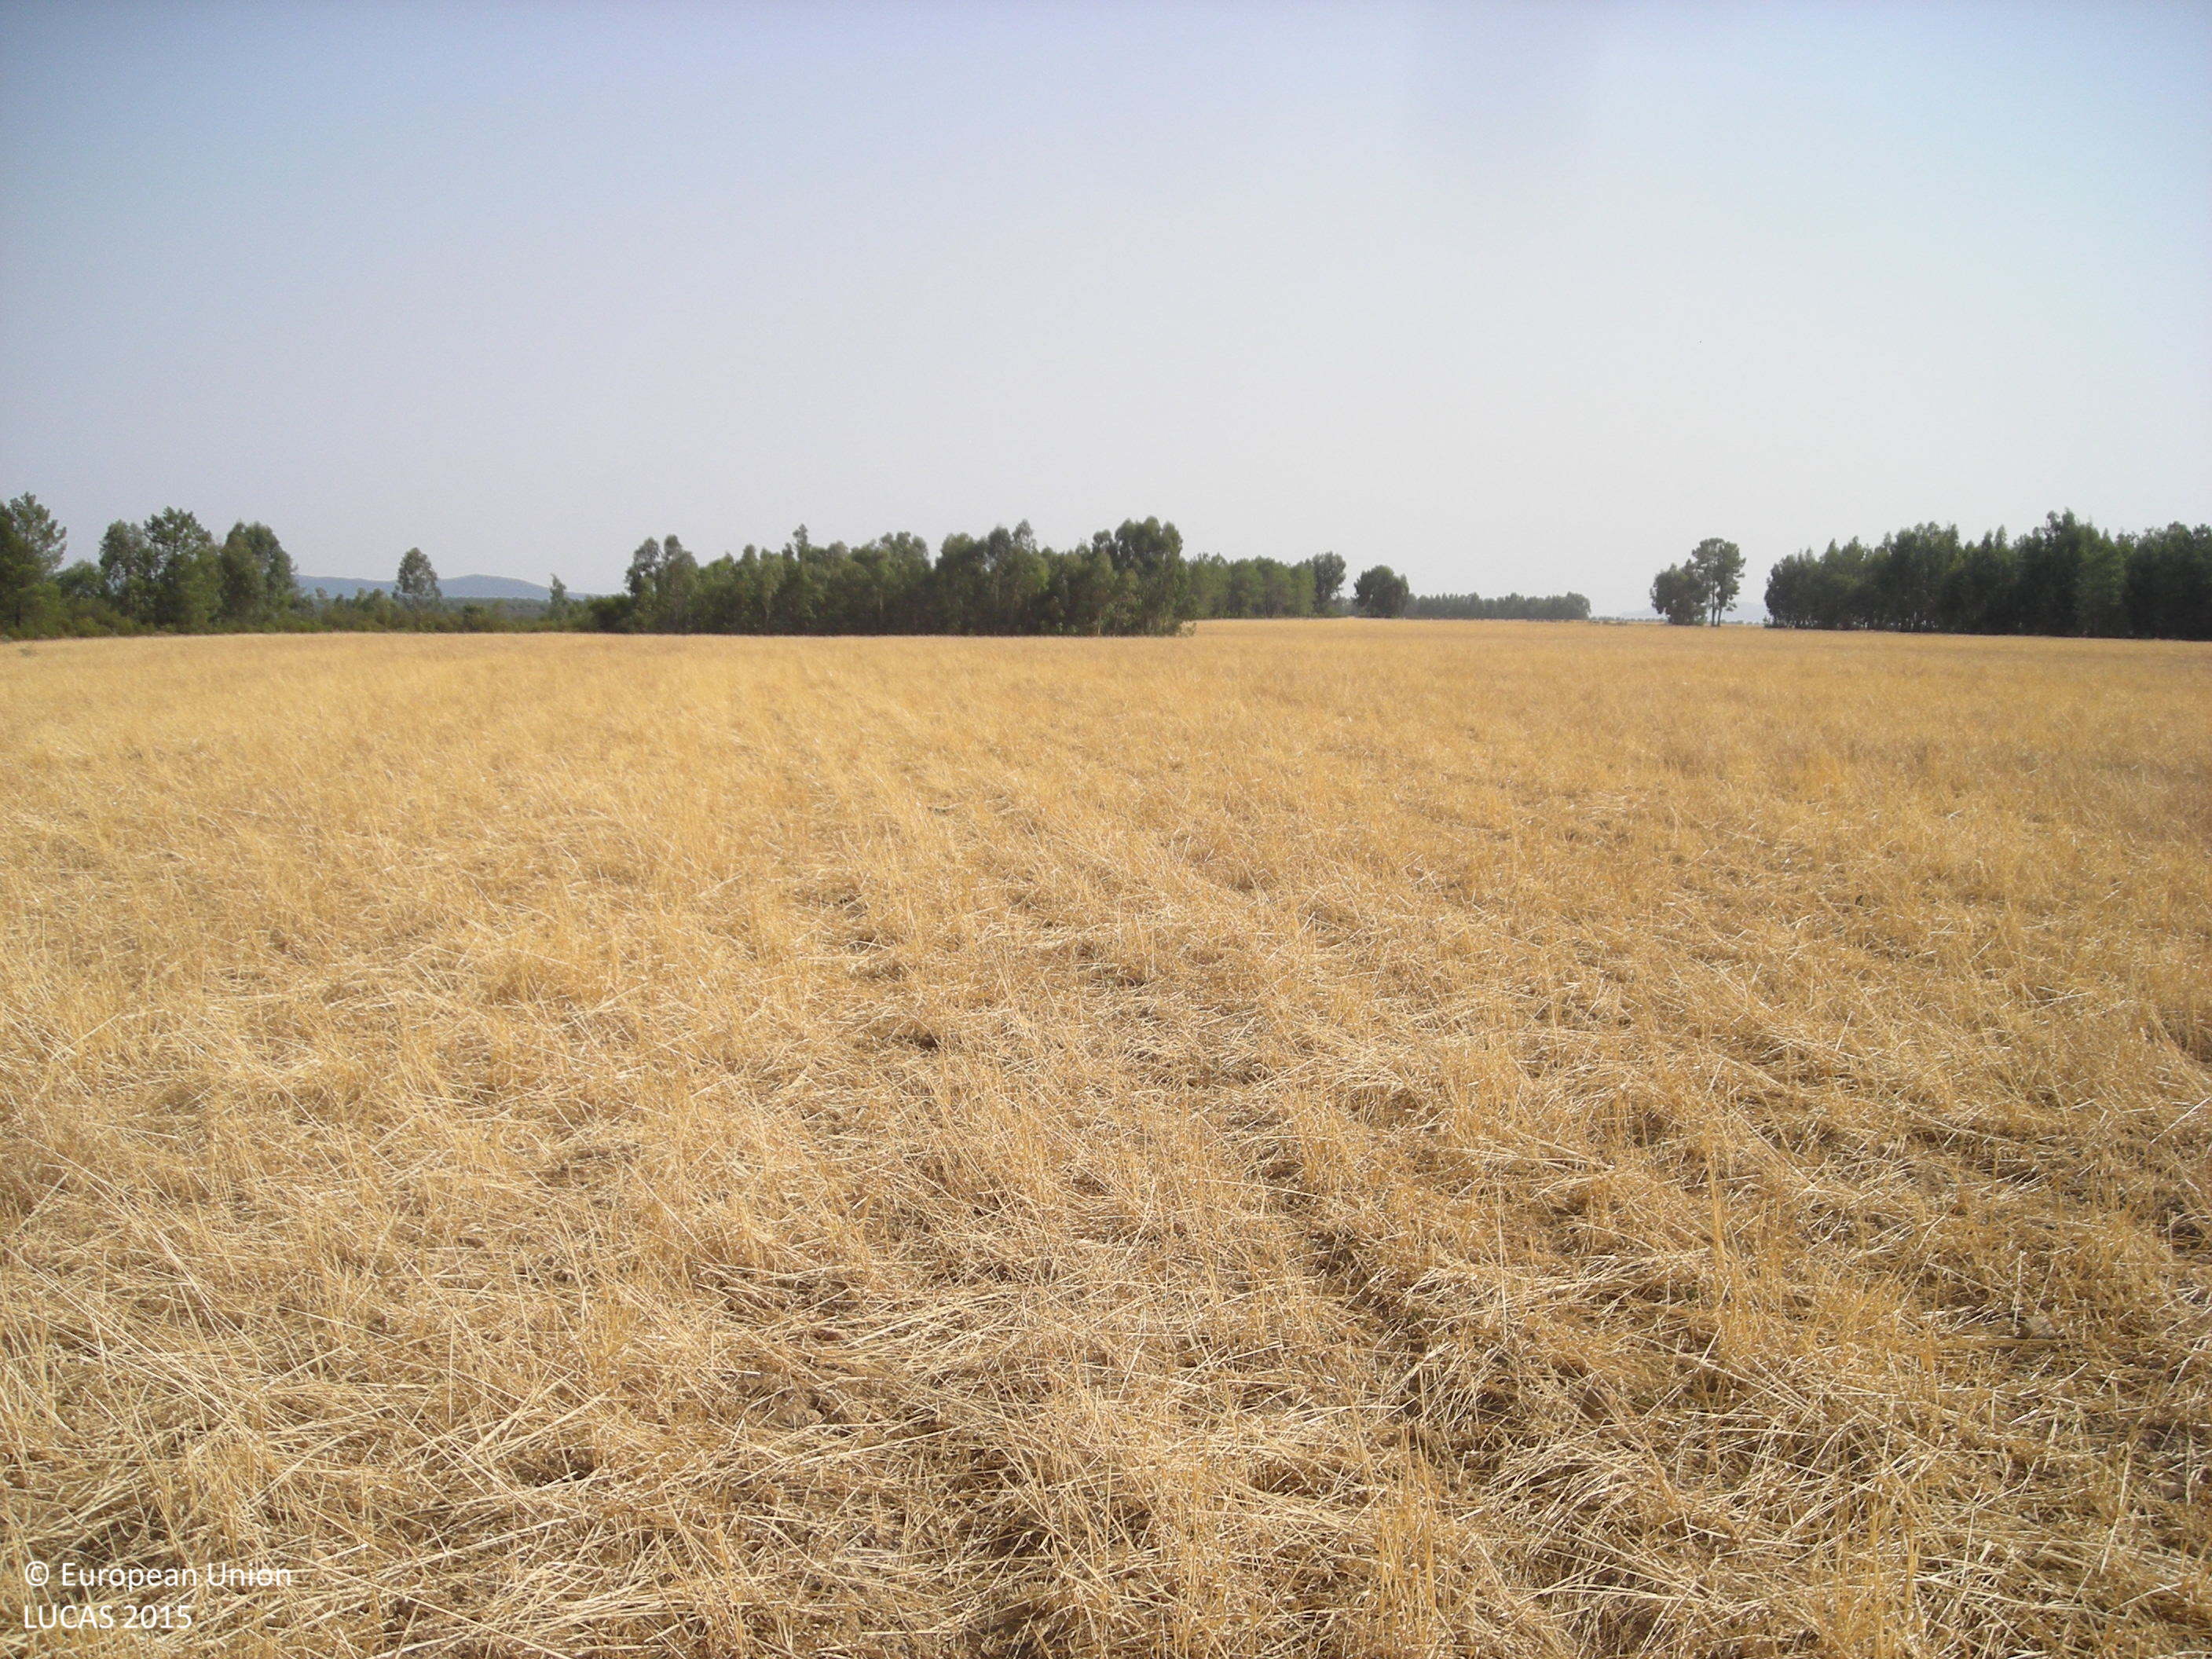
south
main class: Grassland
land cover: Grassland without tree/shrub cover
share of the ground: > 75 %
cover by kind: herbaceous plants 100 %
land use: Agriculture (excluding fallow land and kitchen gardens)
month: July
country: ES
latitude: 39.3097
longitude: -5.3431
